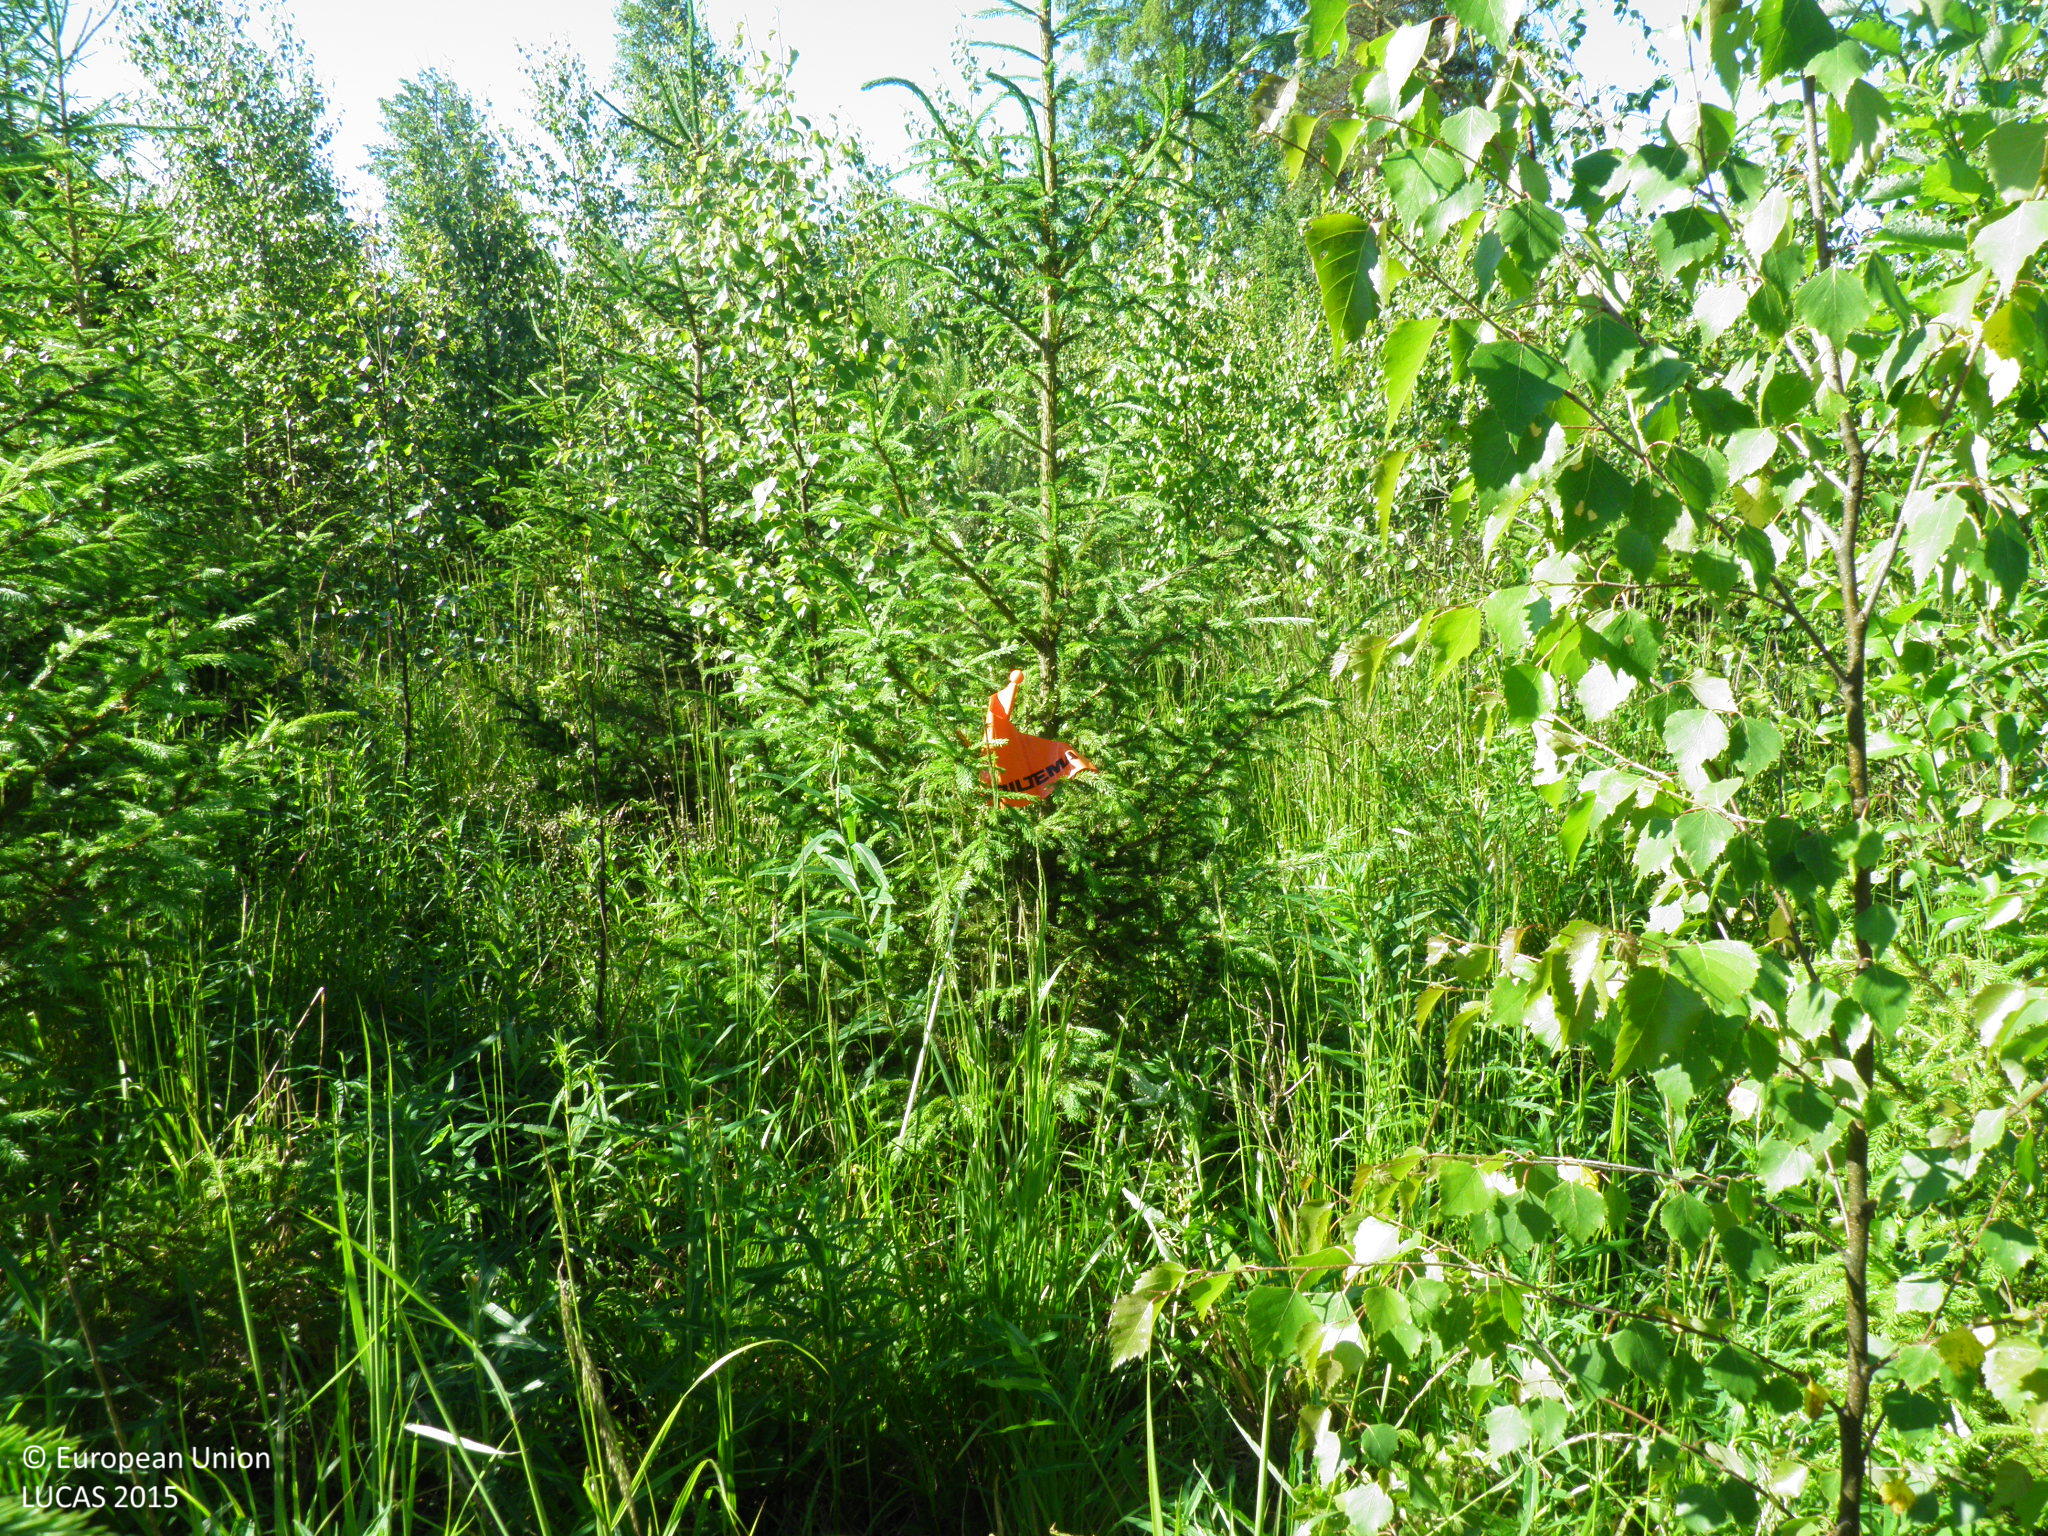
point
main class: Woodland
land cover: Other mixed woodland
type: hemiboreal forest and nemoral coniferous forest and mixed broadleaved-coniferous forest
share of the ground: 50 - 75 %
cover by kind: broadleaved forest trees 55 %, coniferous forest trees 20 %, herbaceous plants 15 %, shrubs 10 %
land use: Forestry
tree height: < 5 m
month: July
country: FI
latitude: 60.5256
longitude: 22.8105
